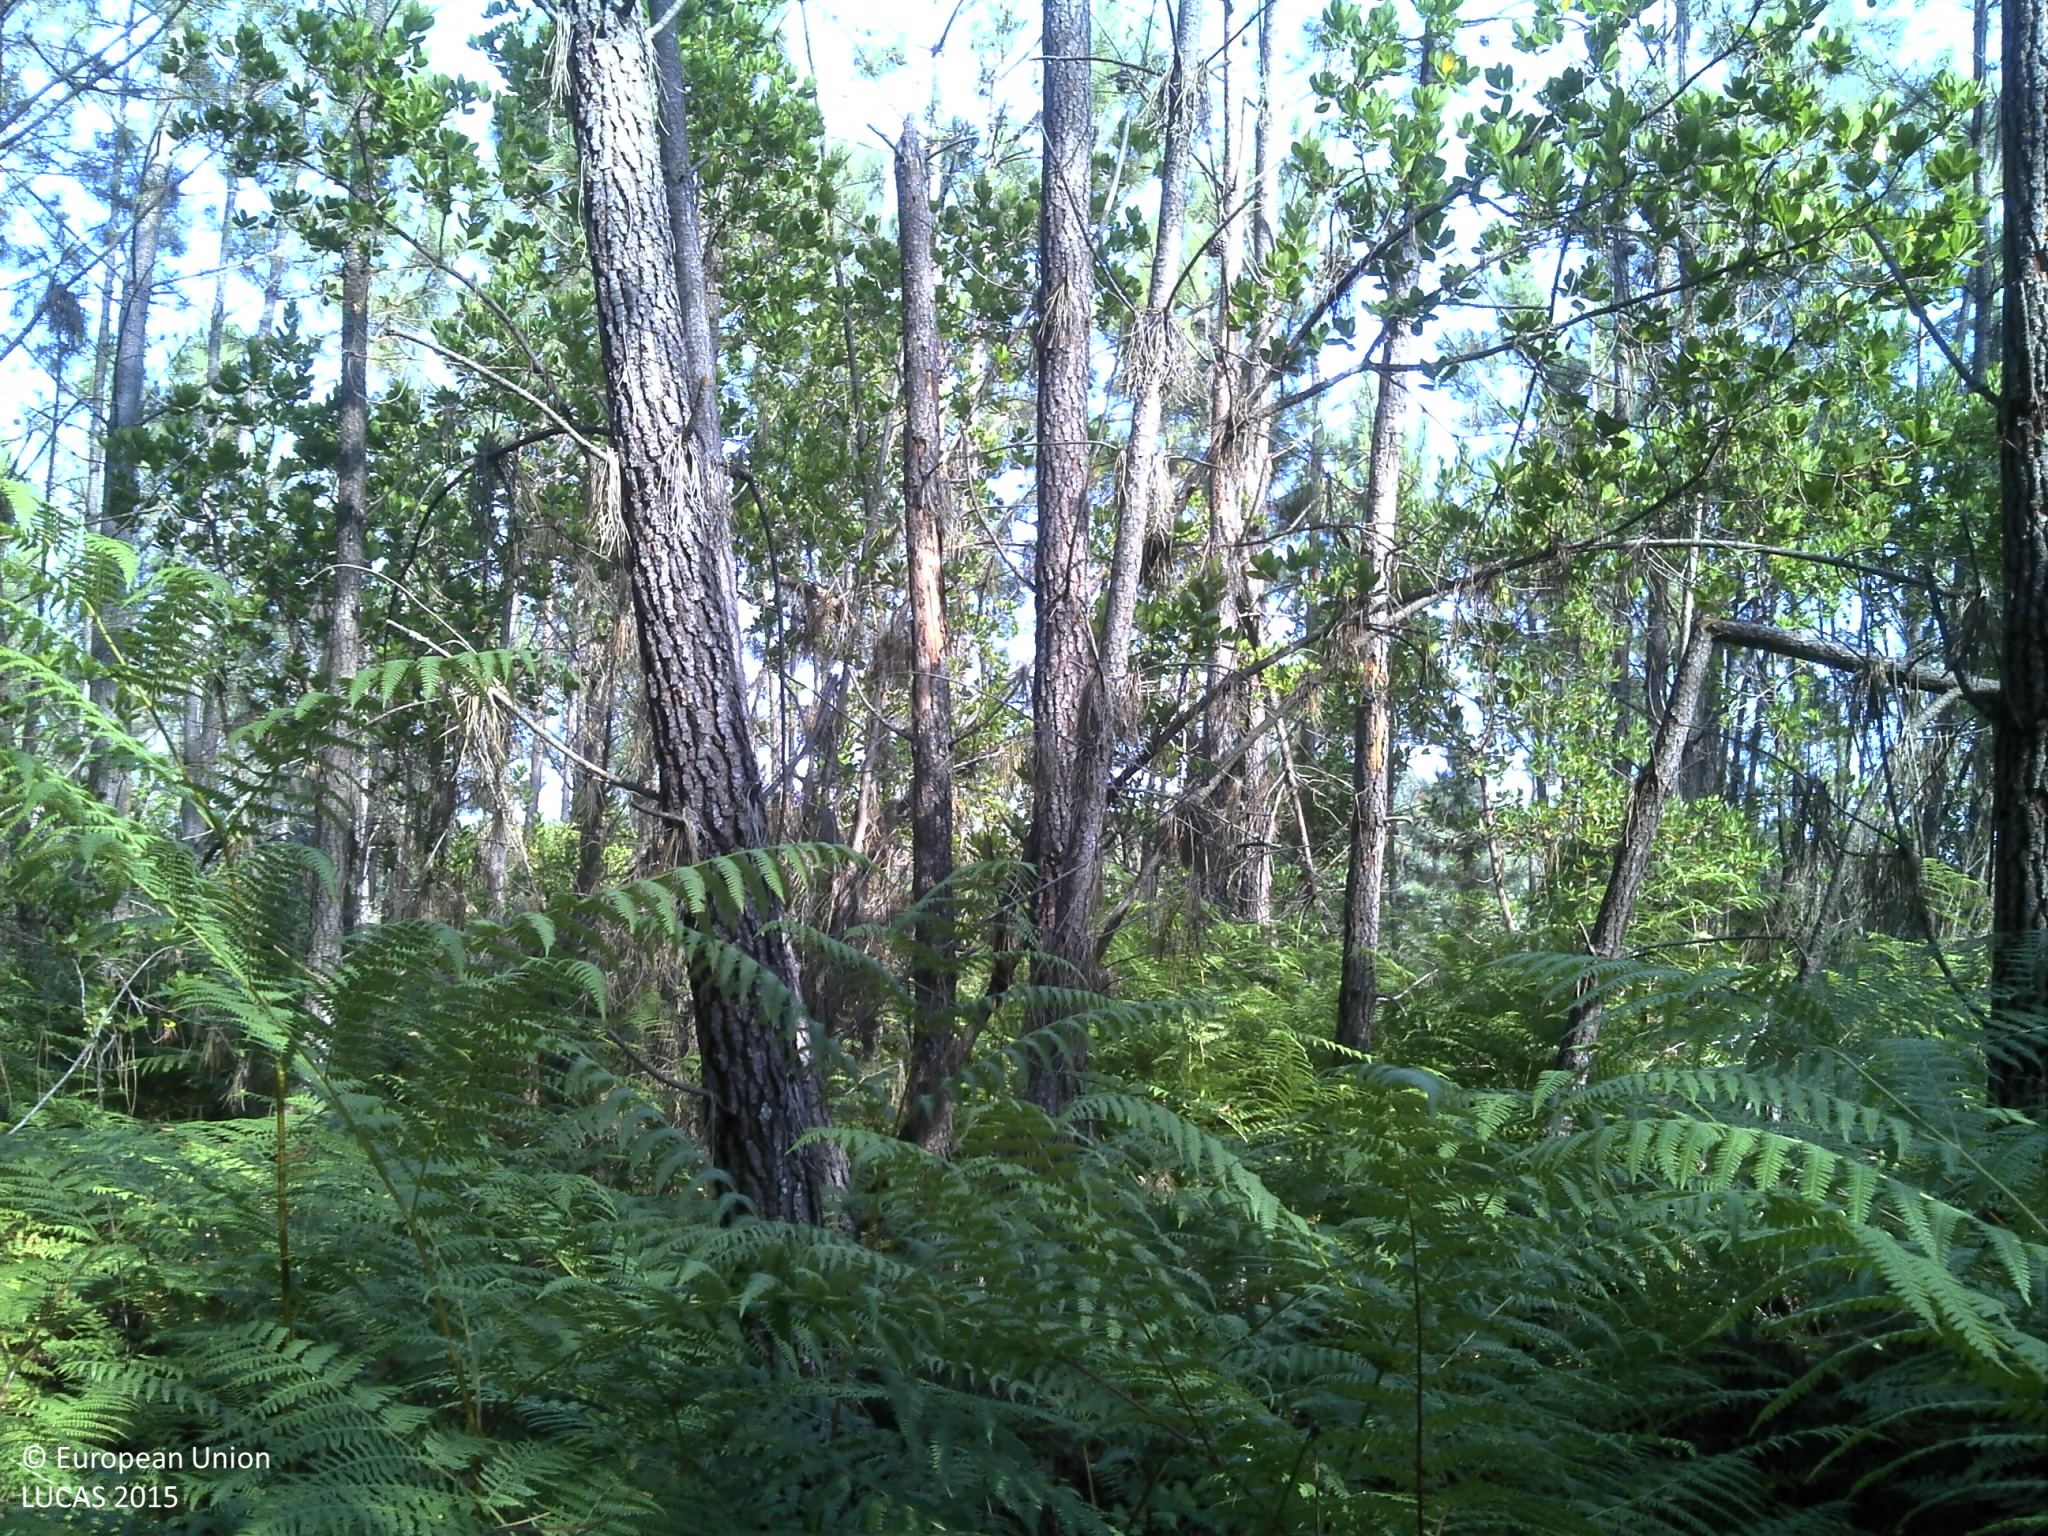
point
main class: Woodland
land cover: Pine dominated coniferous woodland
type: coniferous forest of the mediterranean region
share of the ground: 50 - 75 %
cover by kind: coniferous forest trees 75 %, shrubs 15 %, unconsolidated bare surface 10 %
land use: Forestry
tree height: > 5 m
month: July
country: PT
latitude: 40.2417
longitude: -8.1434
